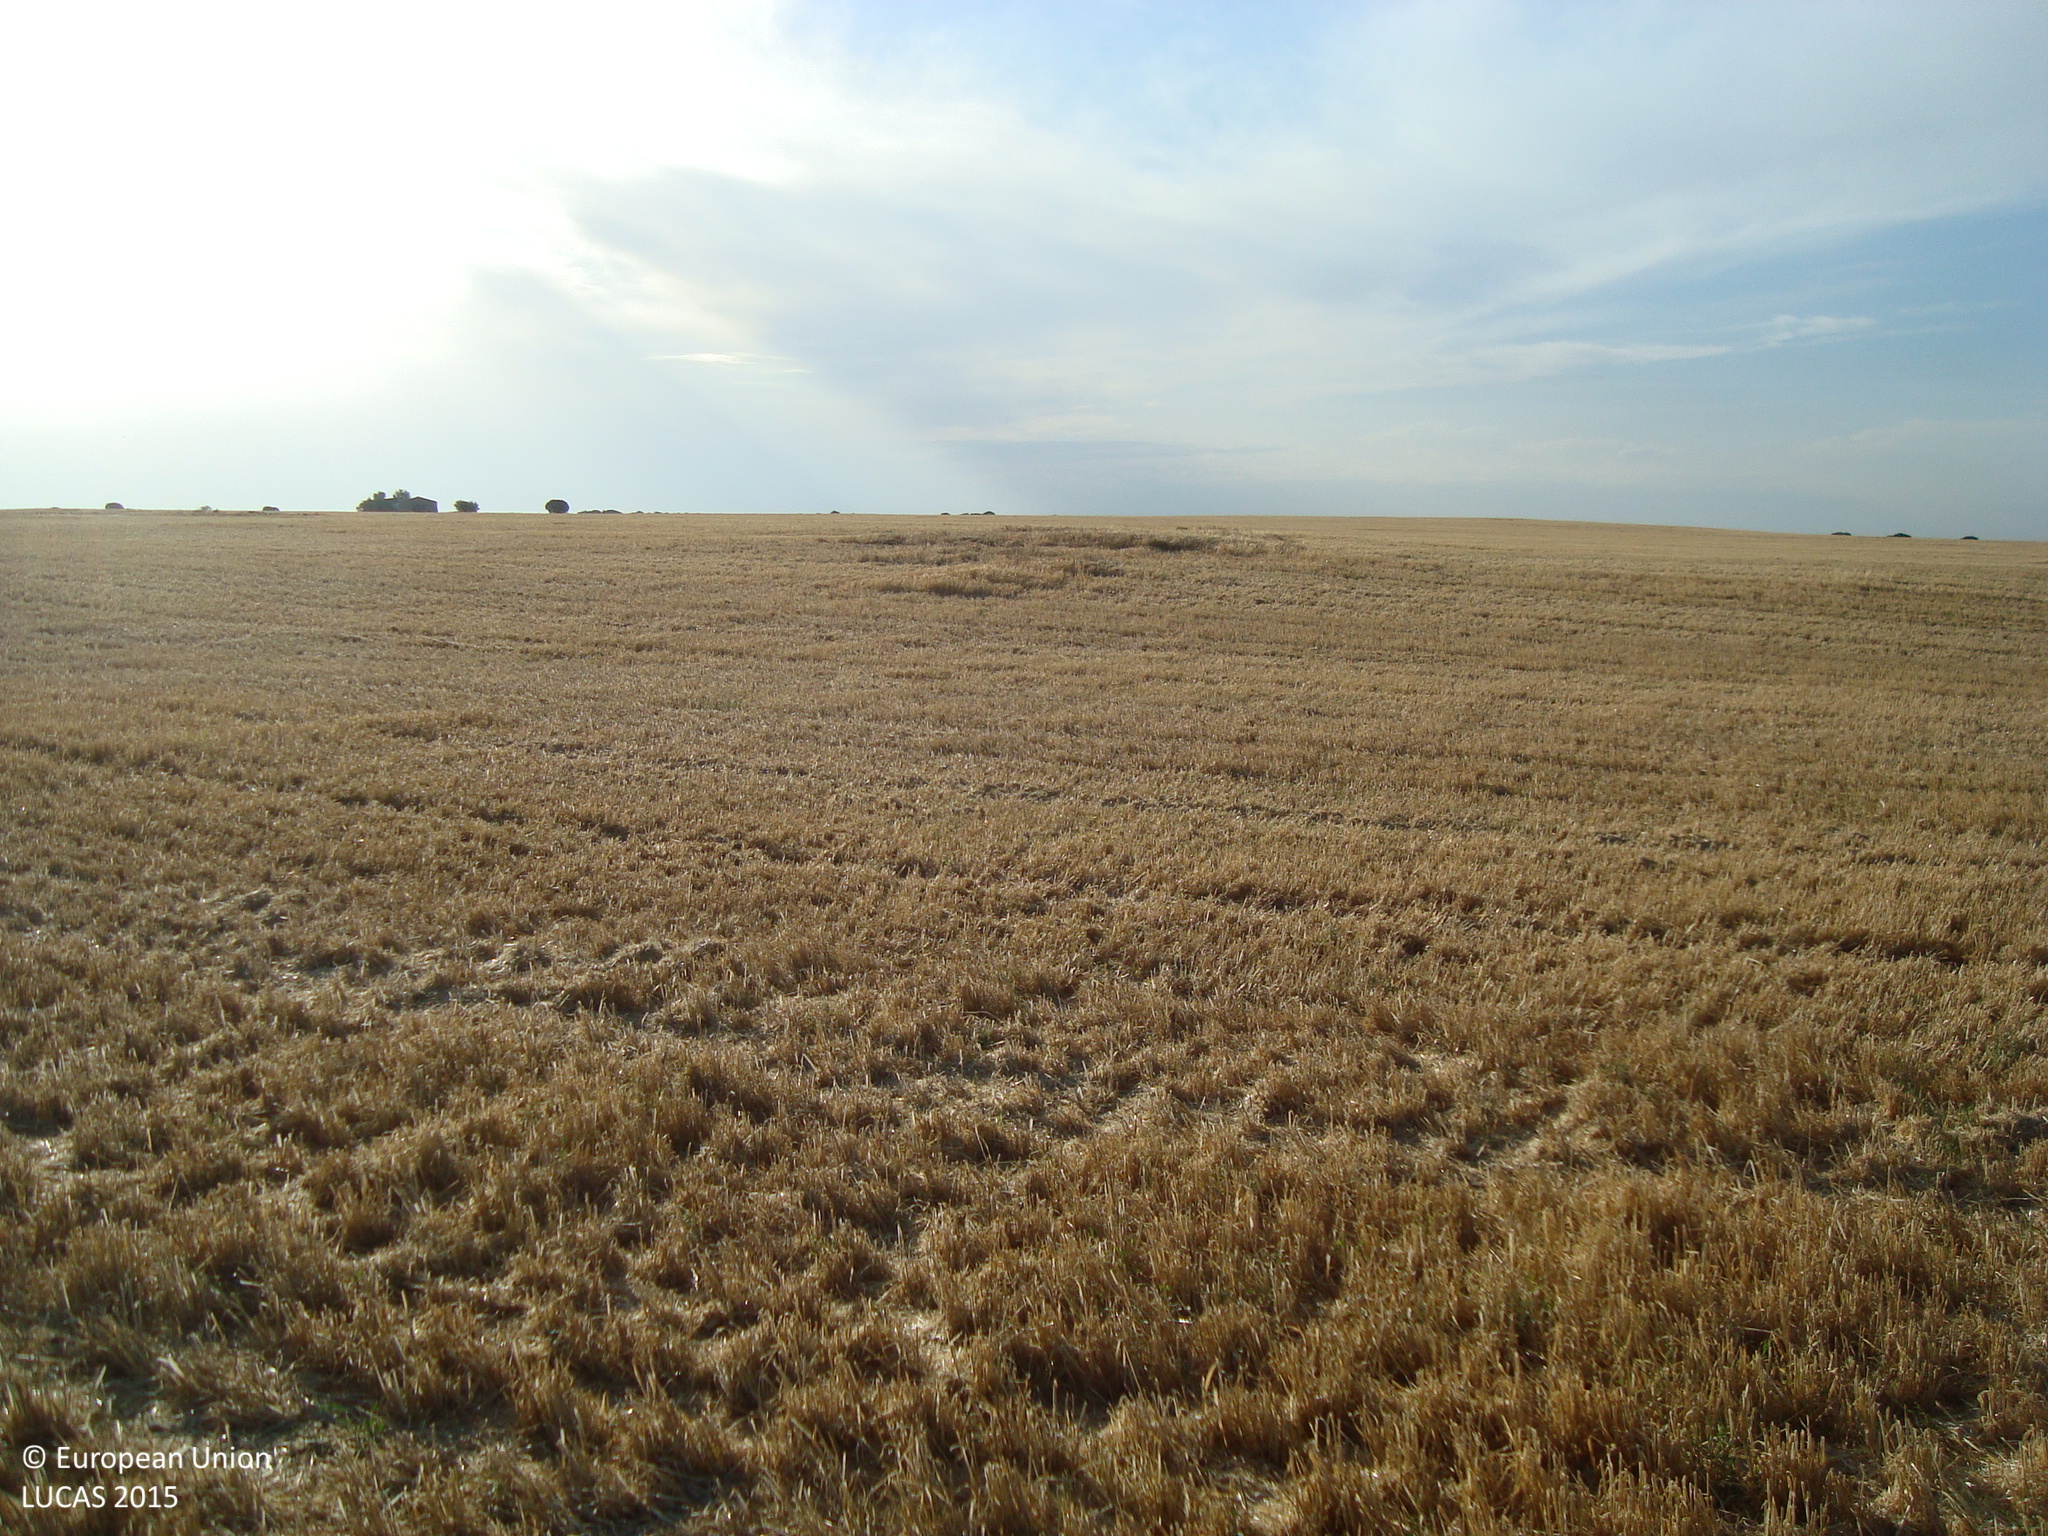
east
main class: Cropland
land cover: Barley
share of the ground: > 75 %
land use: Agriculture (excluding fallow land and kitchen gardens)
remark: Harvested field
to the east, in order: Barley
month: July
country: ES
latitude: 41.8935
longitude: -4.2746
